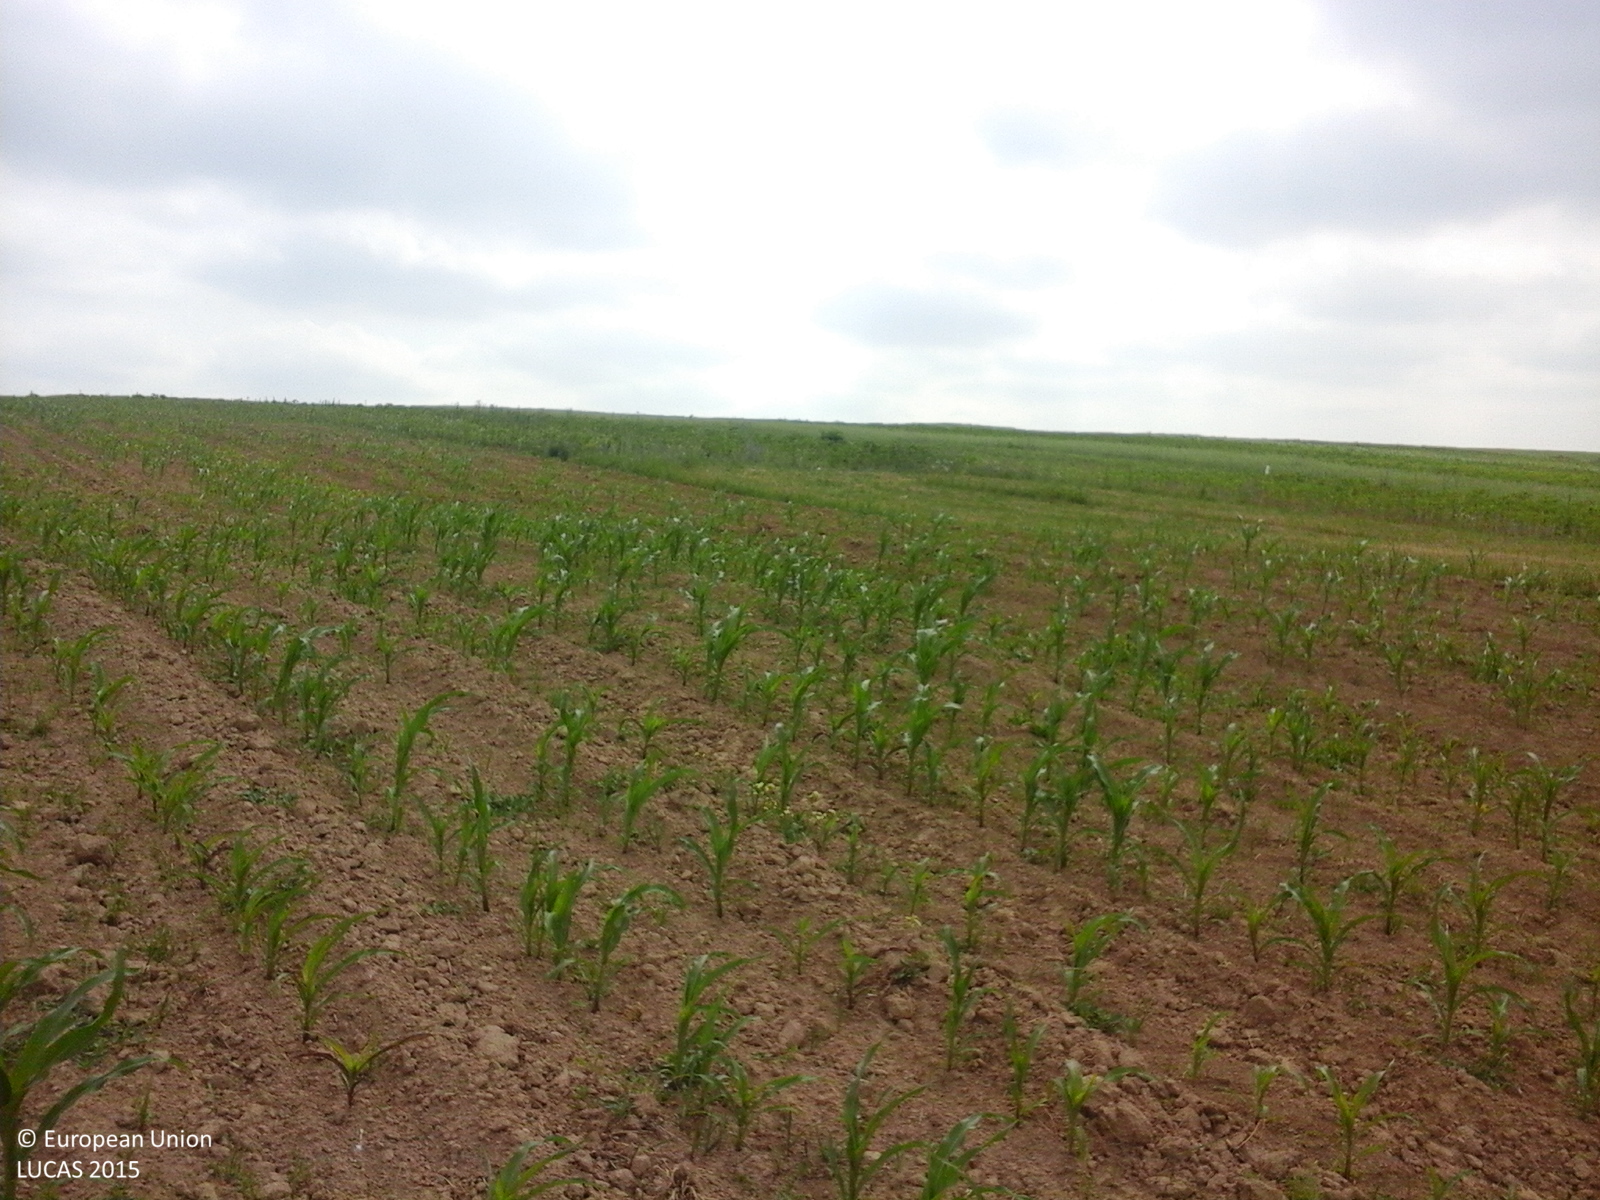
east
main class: Cropland
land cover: Maize
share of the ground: 10 - 25 %
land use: Agriculture (excluding fallow land and kitchen gardens)
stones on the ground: < 10 %
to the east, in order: Maize; Grassland without tree/shrub cover; Sunflower; Oats; Soya; Sunflower
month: June
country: RO
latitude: 47.6181
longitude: 26.5767
